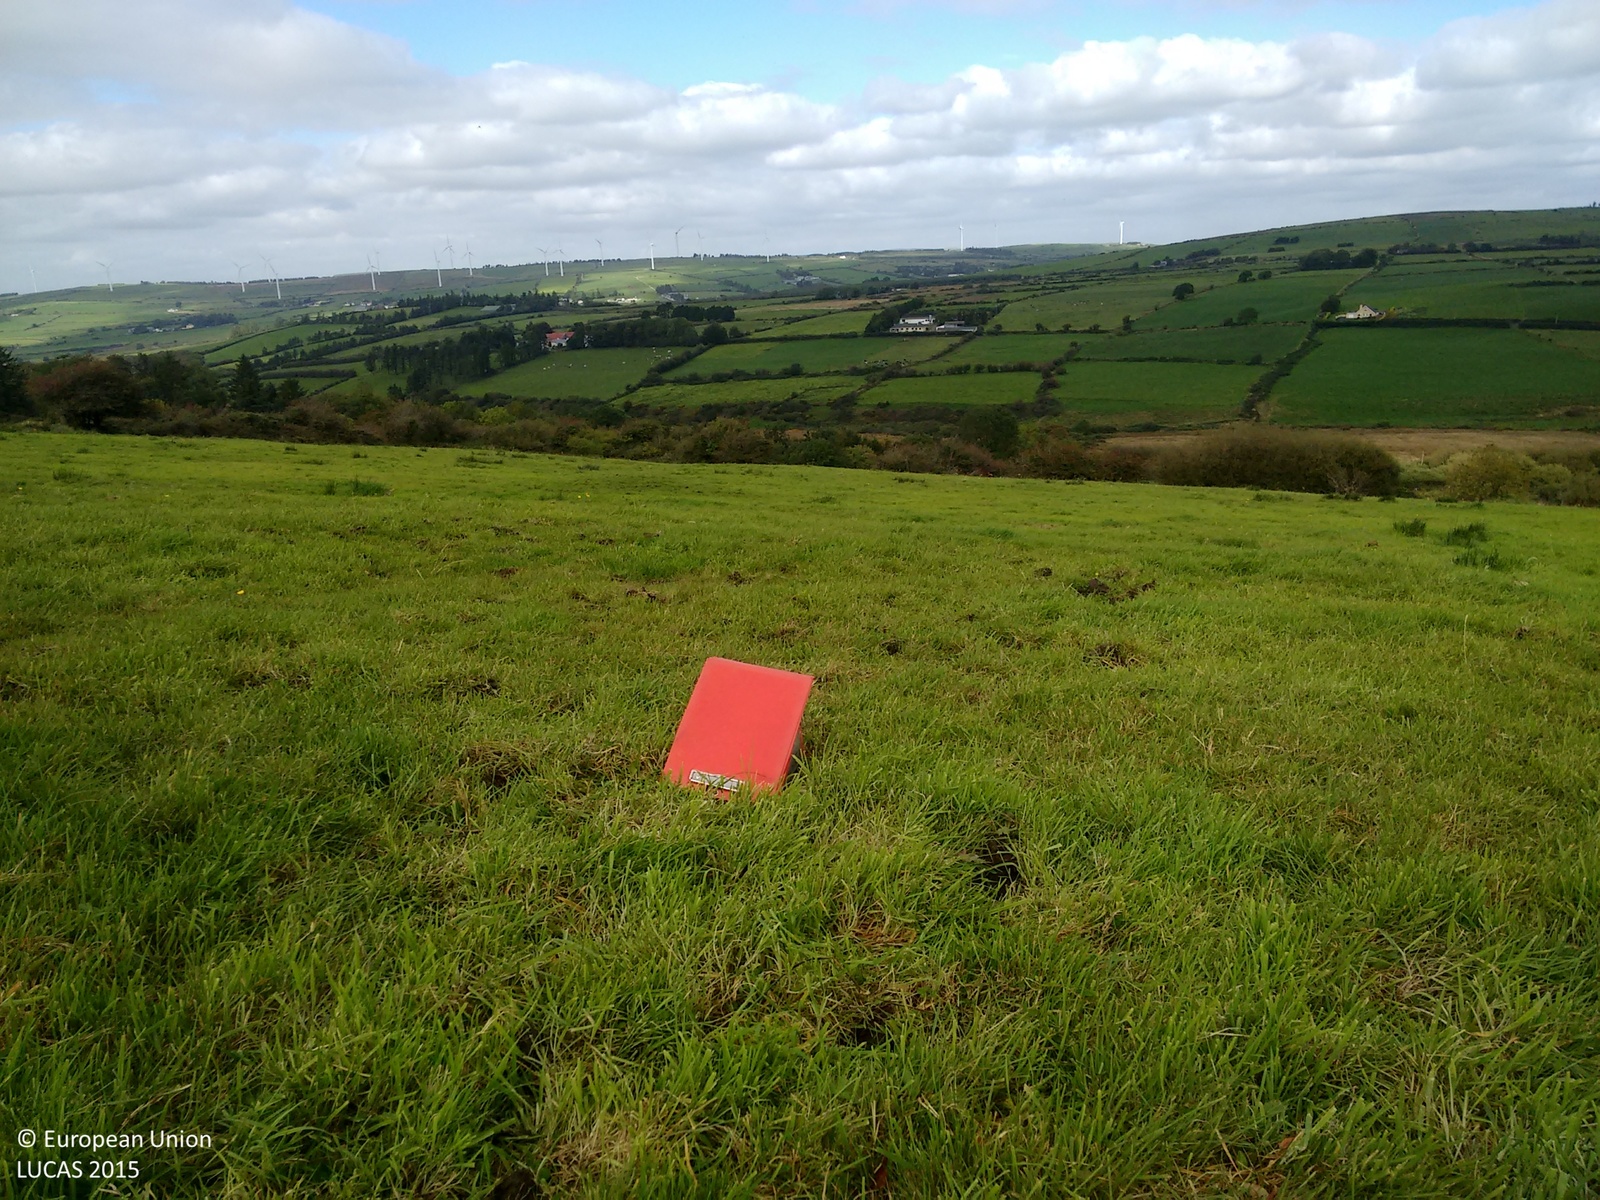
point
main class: Grassland
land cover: Grassland without tree/shrub cover
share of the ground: > 75 %
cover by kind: herbaceous plants 100 %
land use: Agriculture (excluding fallow land and kitchen gardens)
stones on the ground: < 10 %
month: September
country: IE
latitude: 52.3571
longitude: -9.1148
